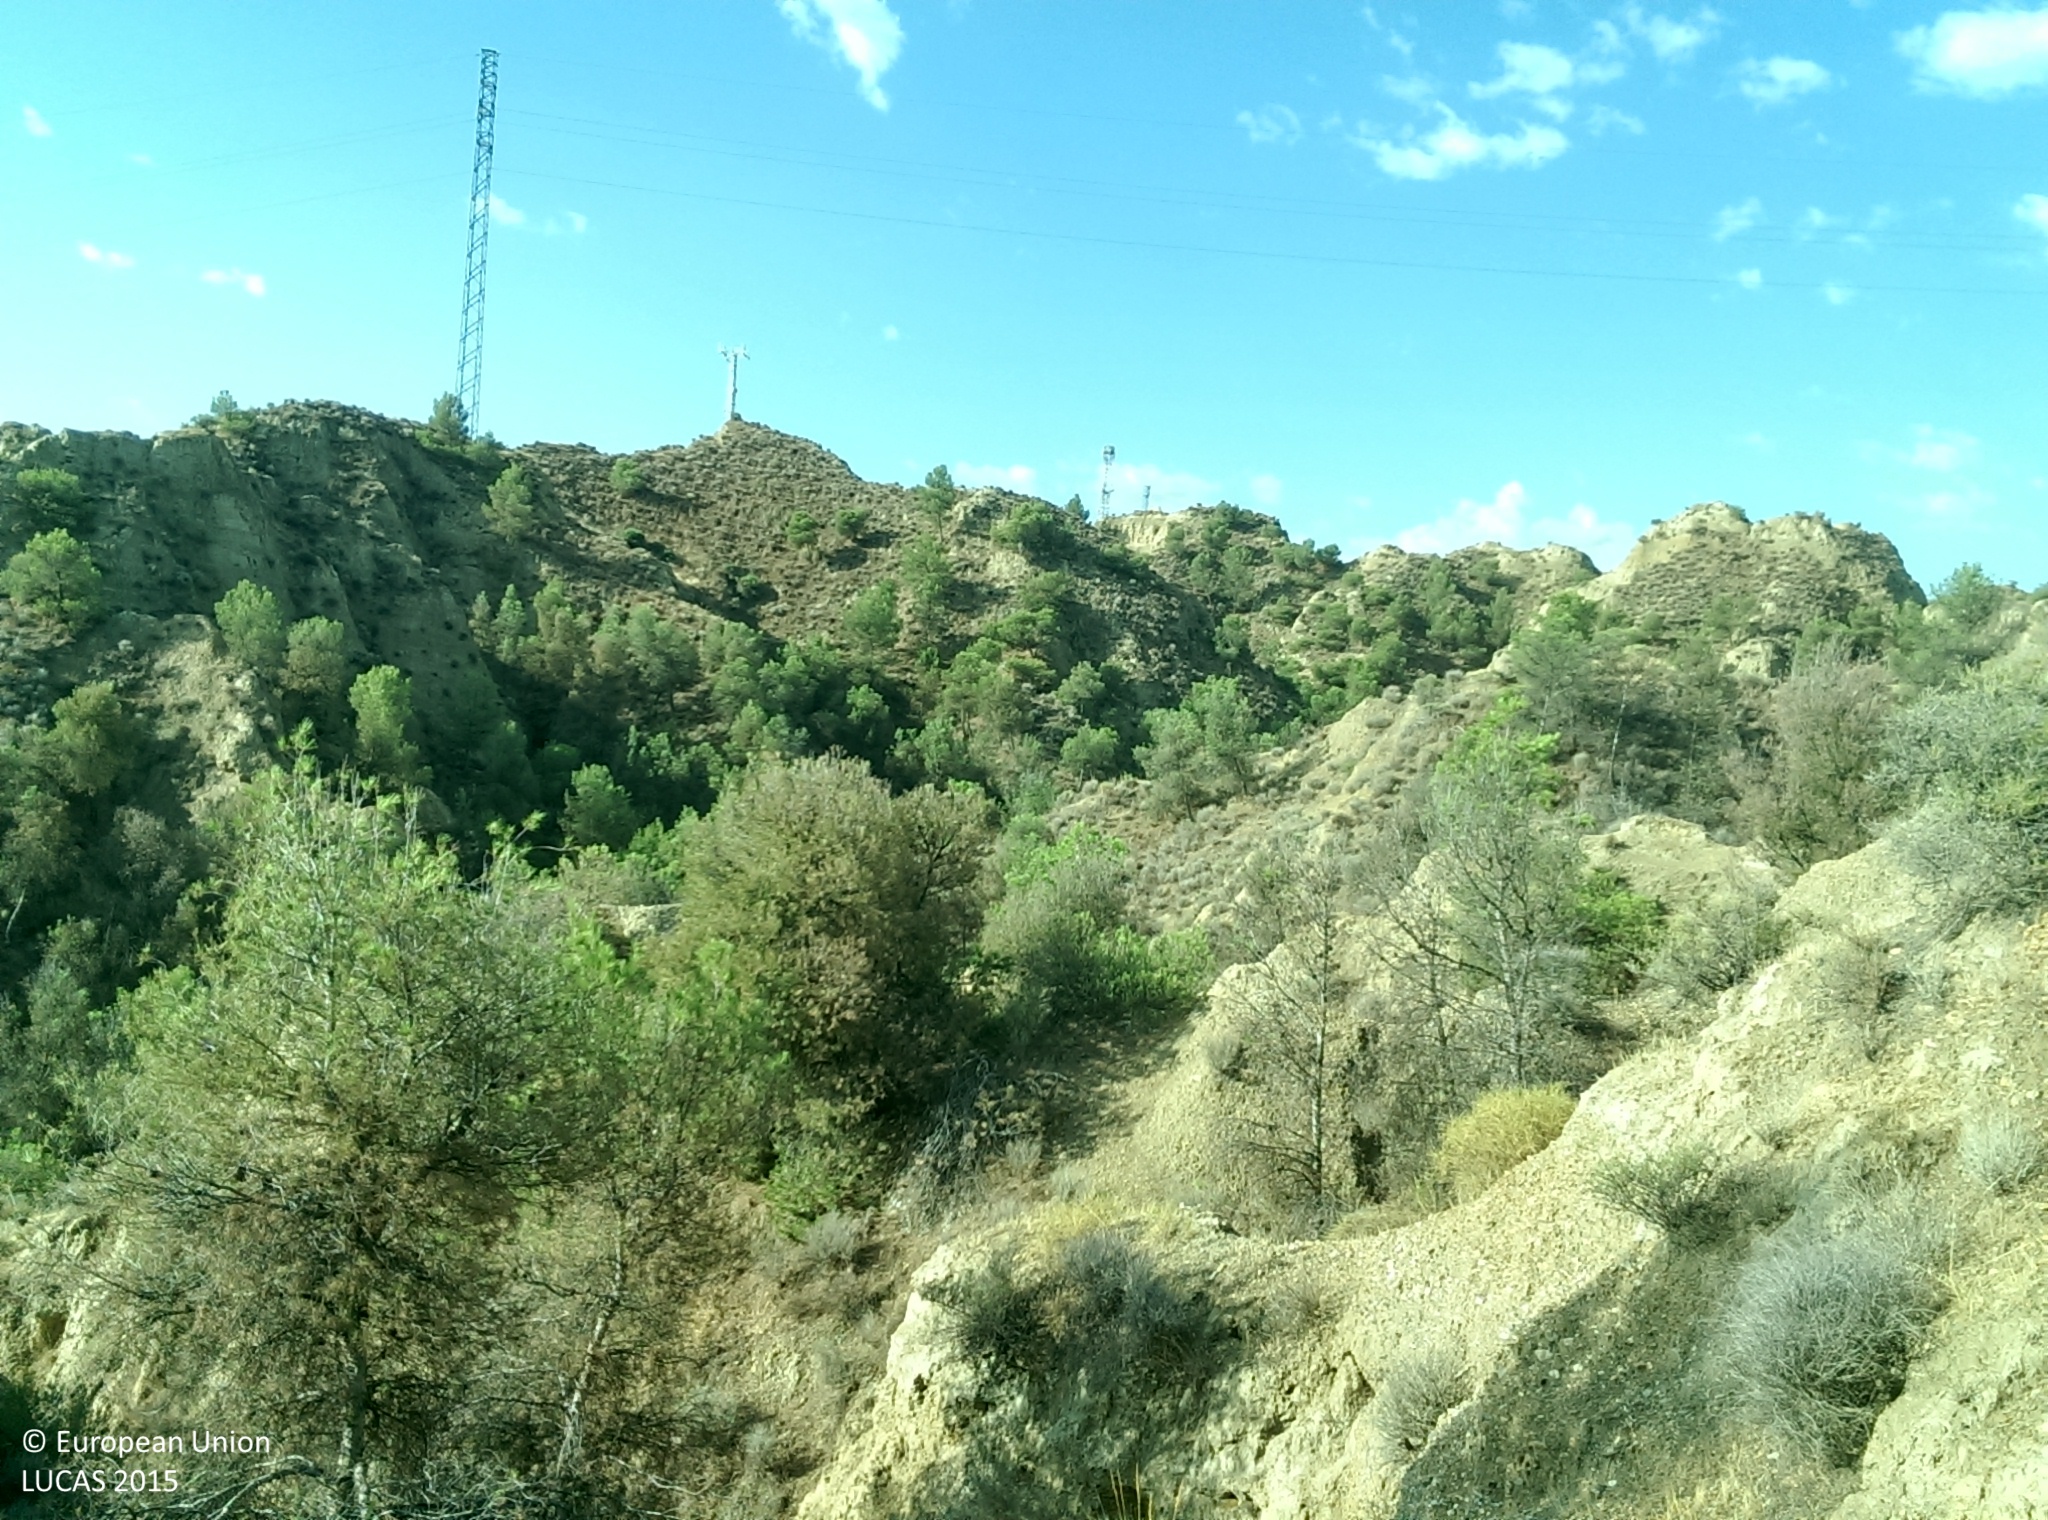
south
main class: Woodland
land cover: Pine dominated coniferous woodland
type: coniferous forest of the mediterranean region
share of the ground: 25 - 50 %
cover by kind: unconsolidated bare surface 40 %, coniferous forest trees 25 %, herbaceous plants 20 %, shrubs 15 %
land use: Forestry
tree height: > 5 m
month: July
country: ES
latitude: 37.3213
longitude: -3.1796
